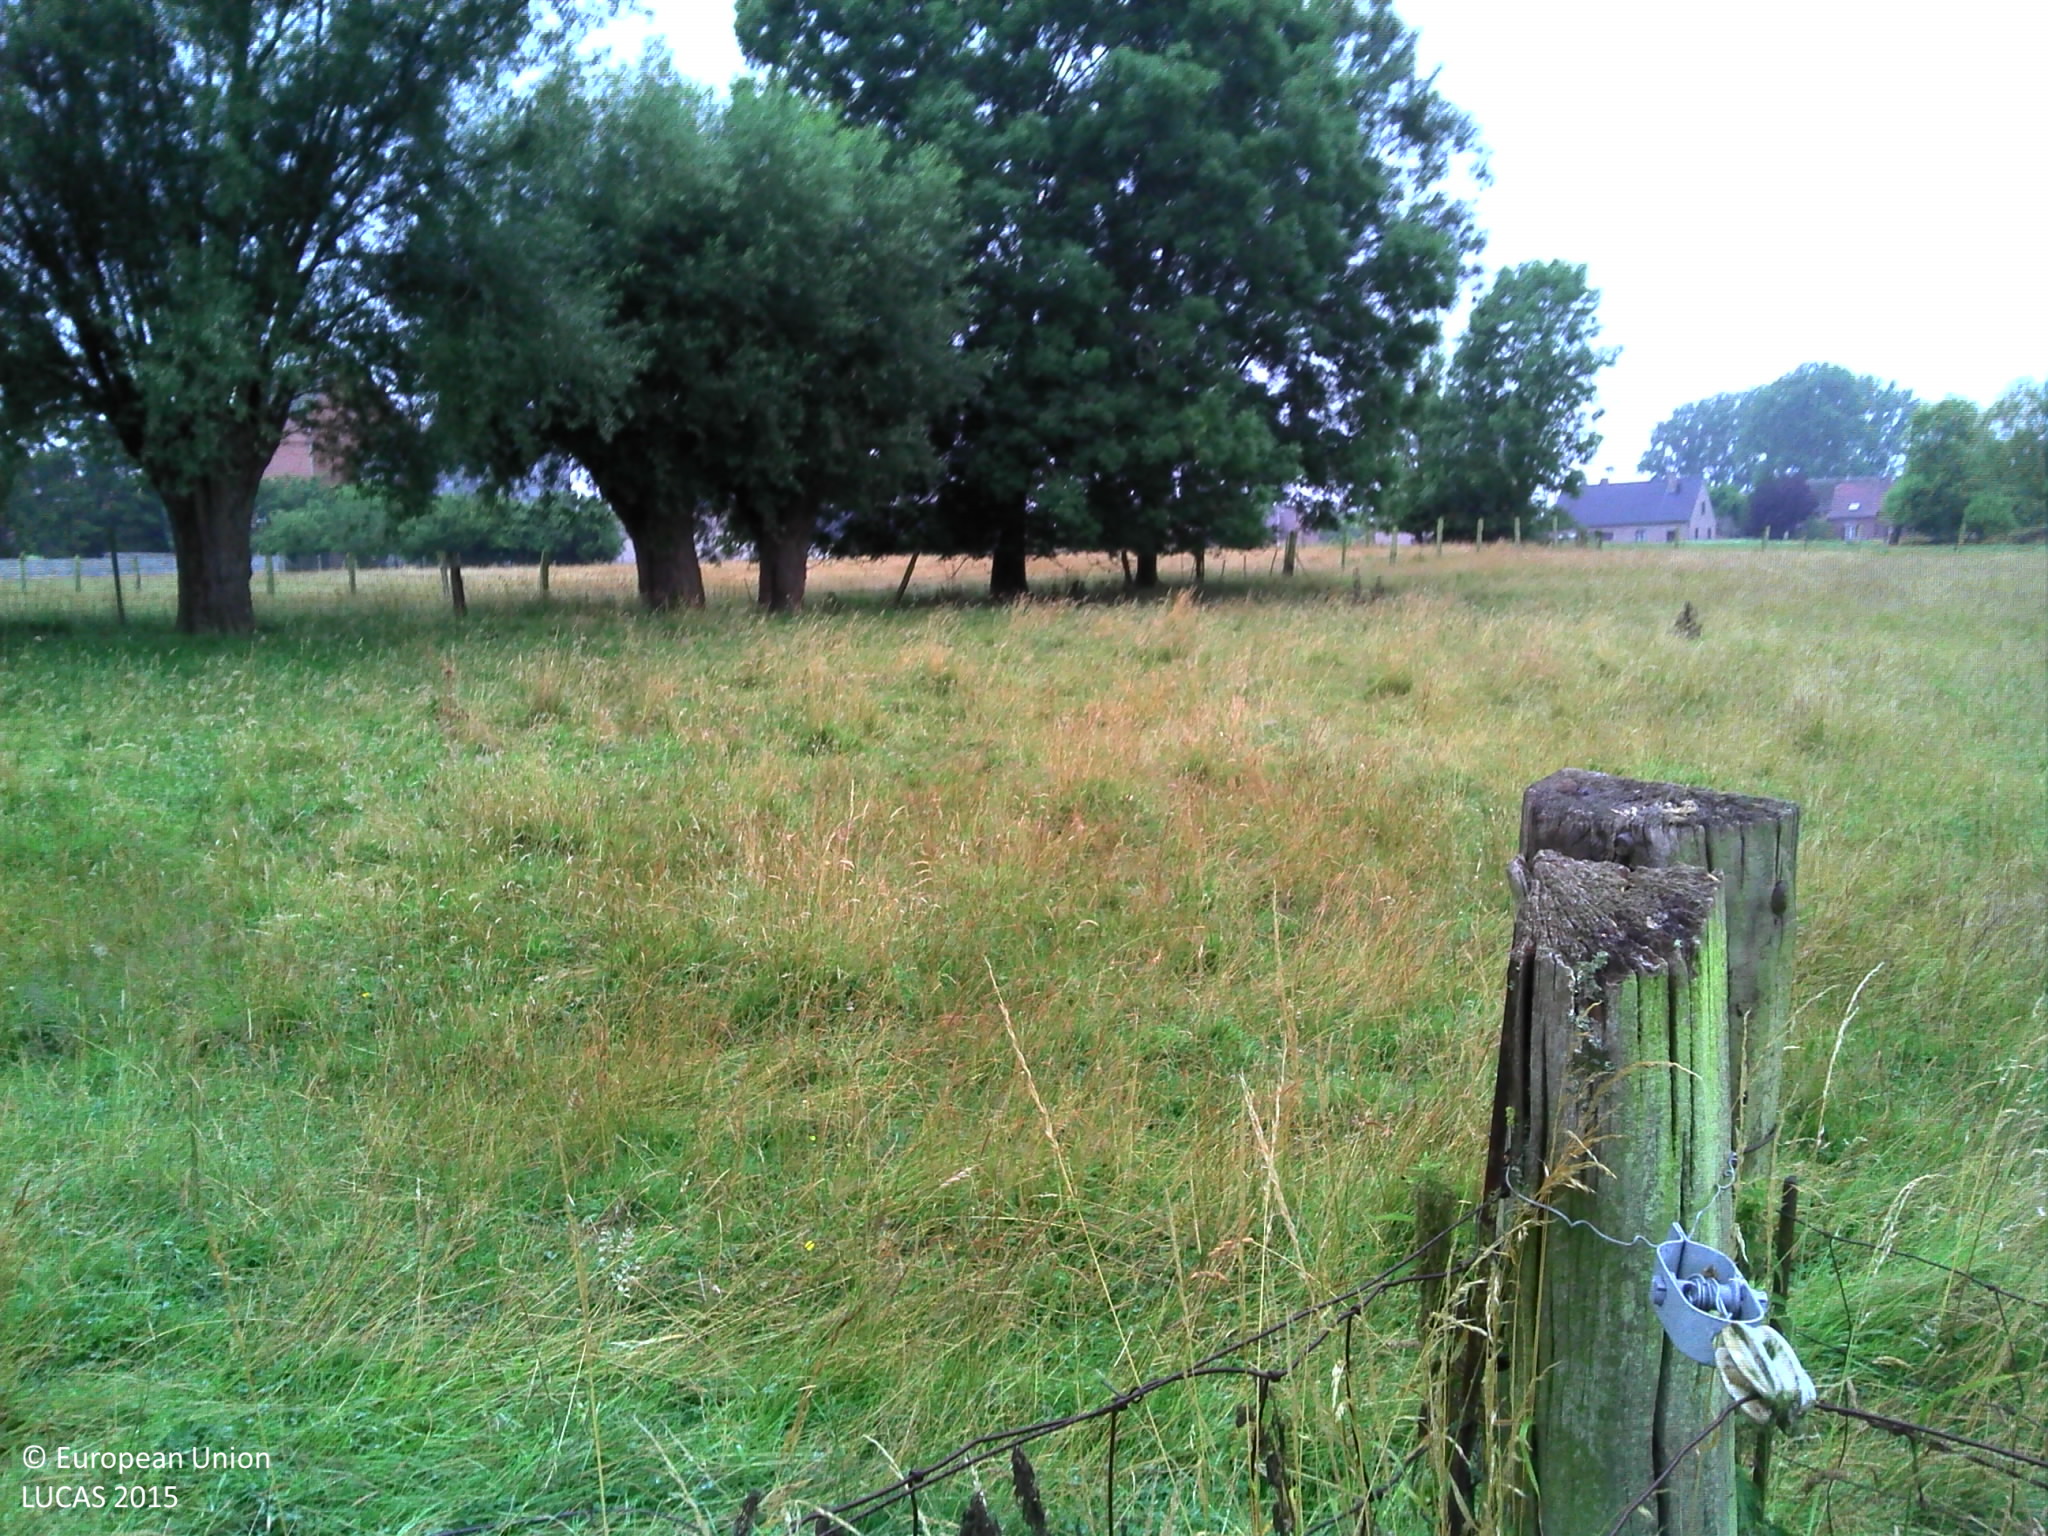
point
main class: Grassland
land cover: Grassland without tree/shrub cover
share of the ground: > 75 %
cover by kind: herbaceous plants 100 %
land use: Agriculture (excluding fallow land and kitchen gardens)
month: July
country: BE
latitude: 50.5848
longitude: 3.9916
